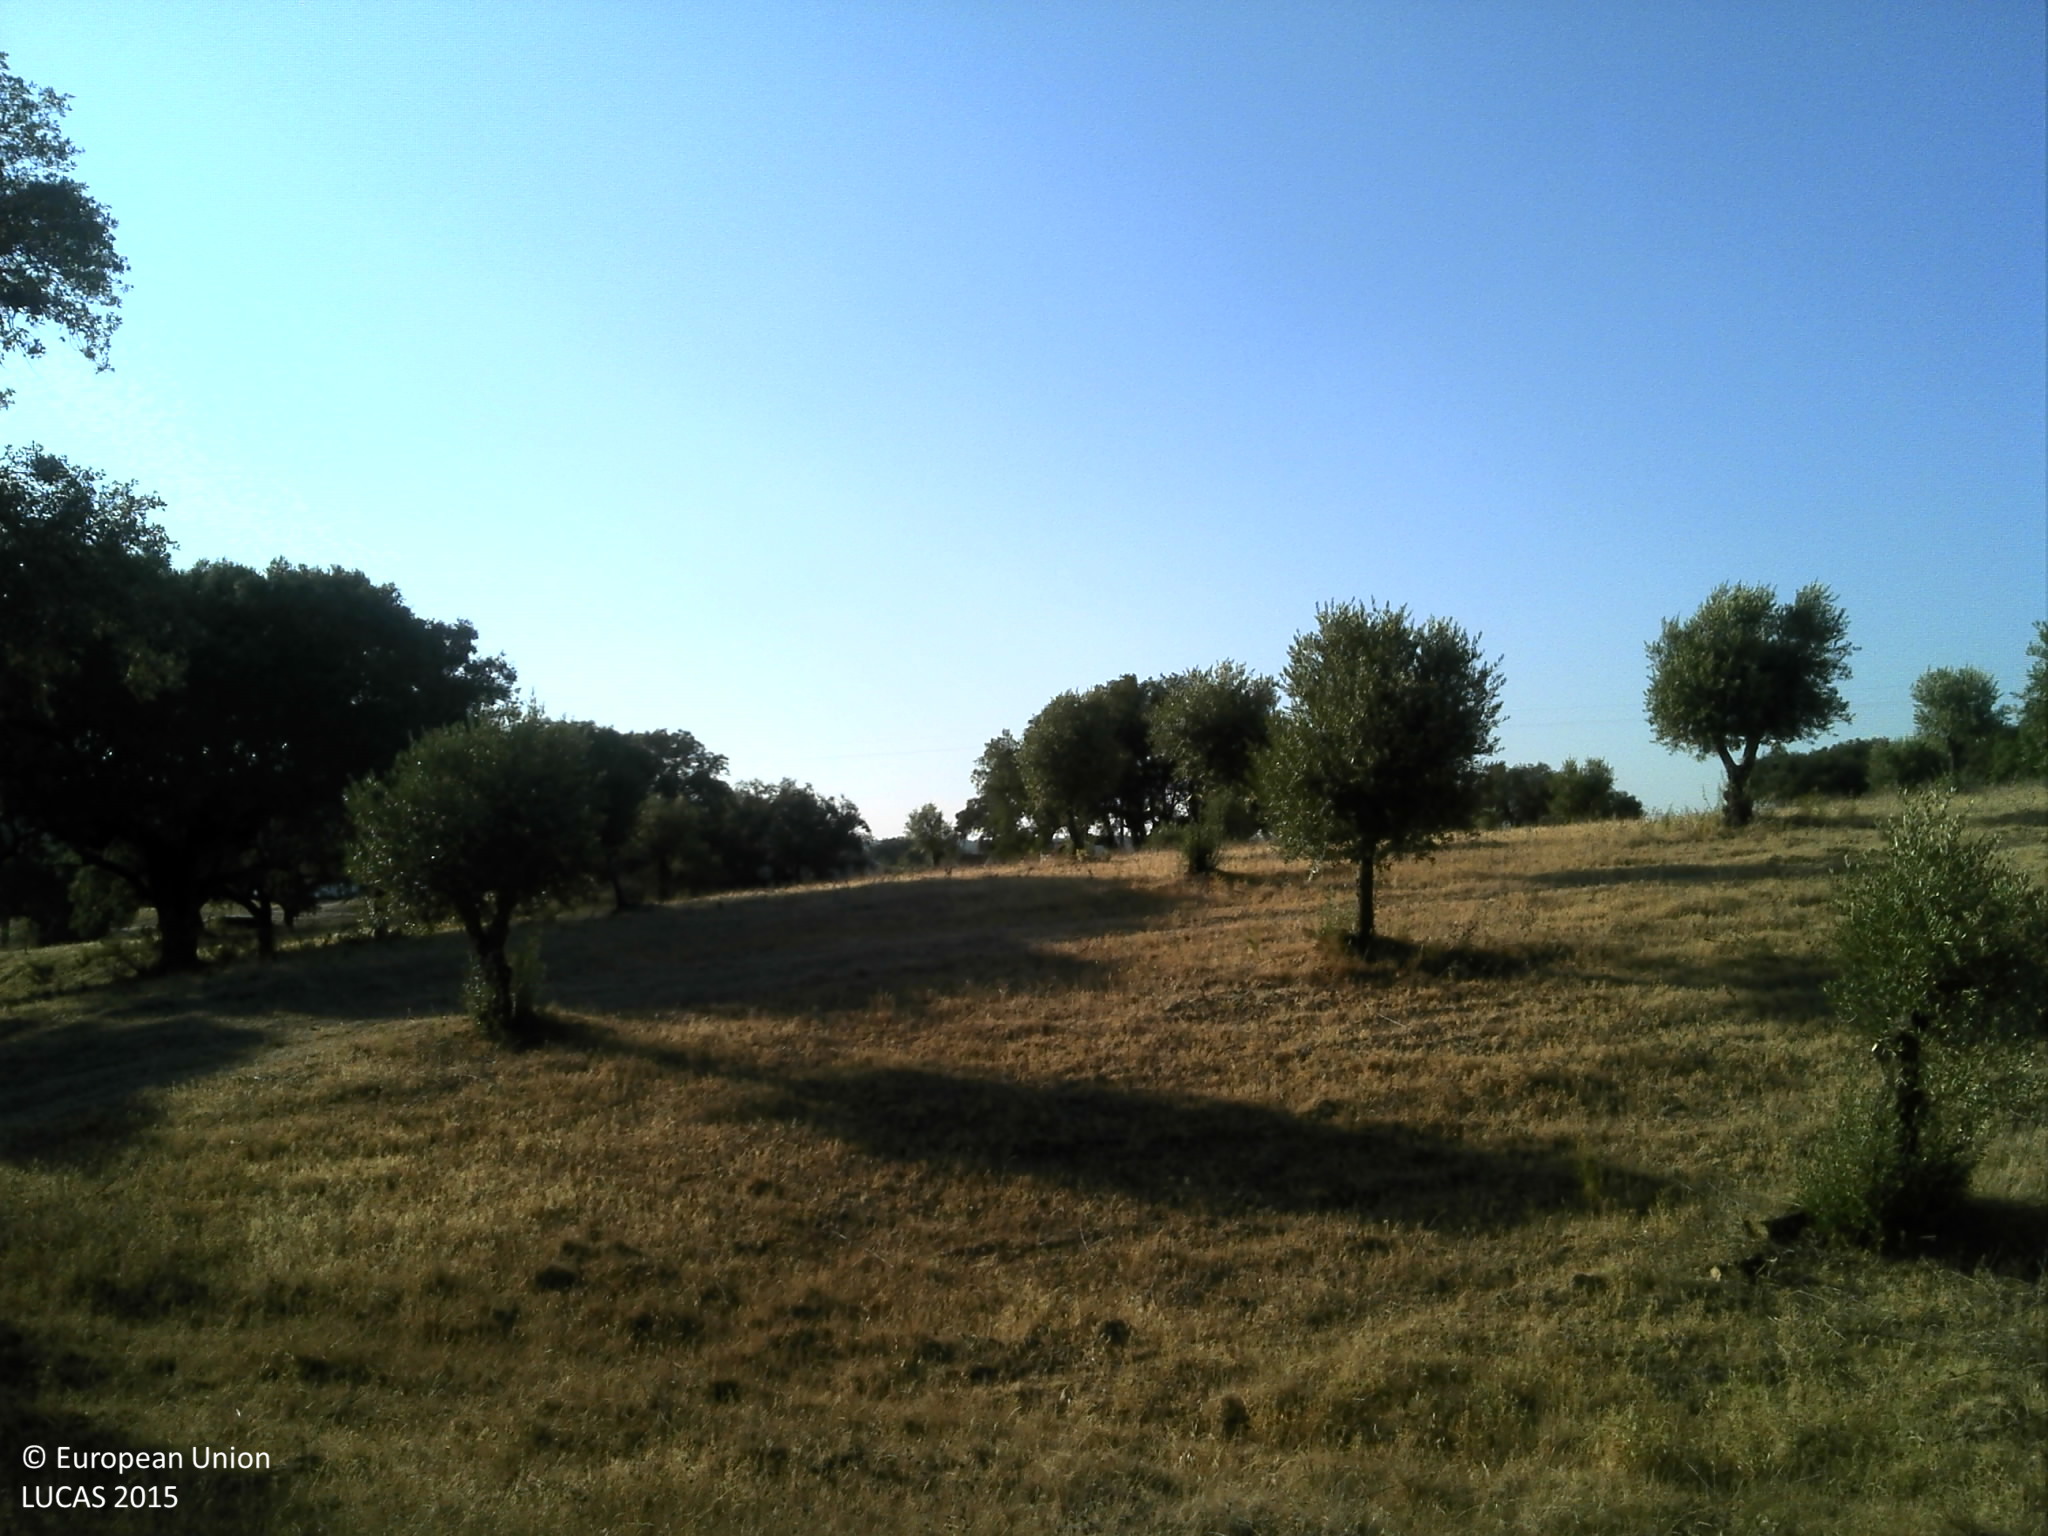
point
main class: Cropland
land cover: Olive groves
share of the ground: 25 - 50 %
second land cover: Grassland without tree/shrub cover
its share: 50 - 75 %
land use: Agriculture (excluding fallow land and kitchen gardens)
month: July
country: PT
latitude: 38.8668
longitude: -8.1810
